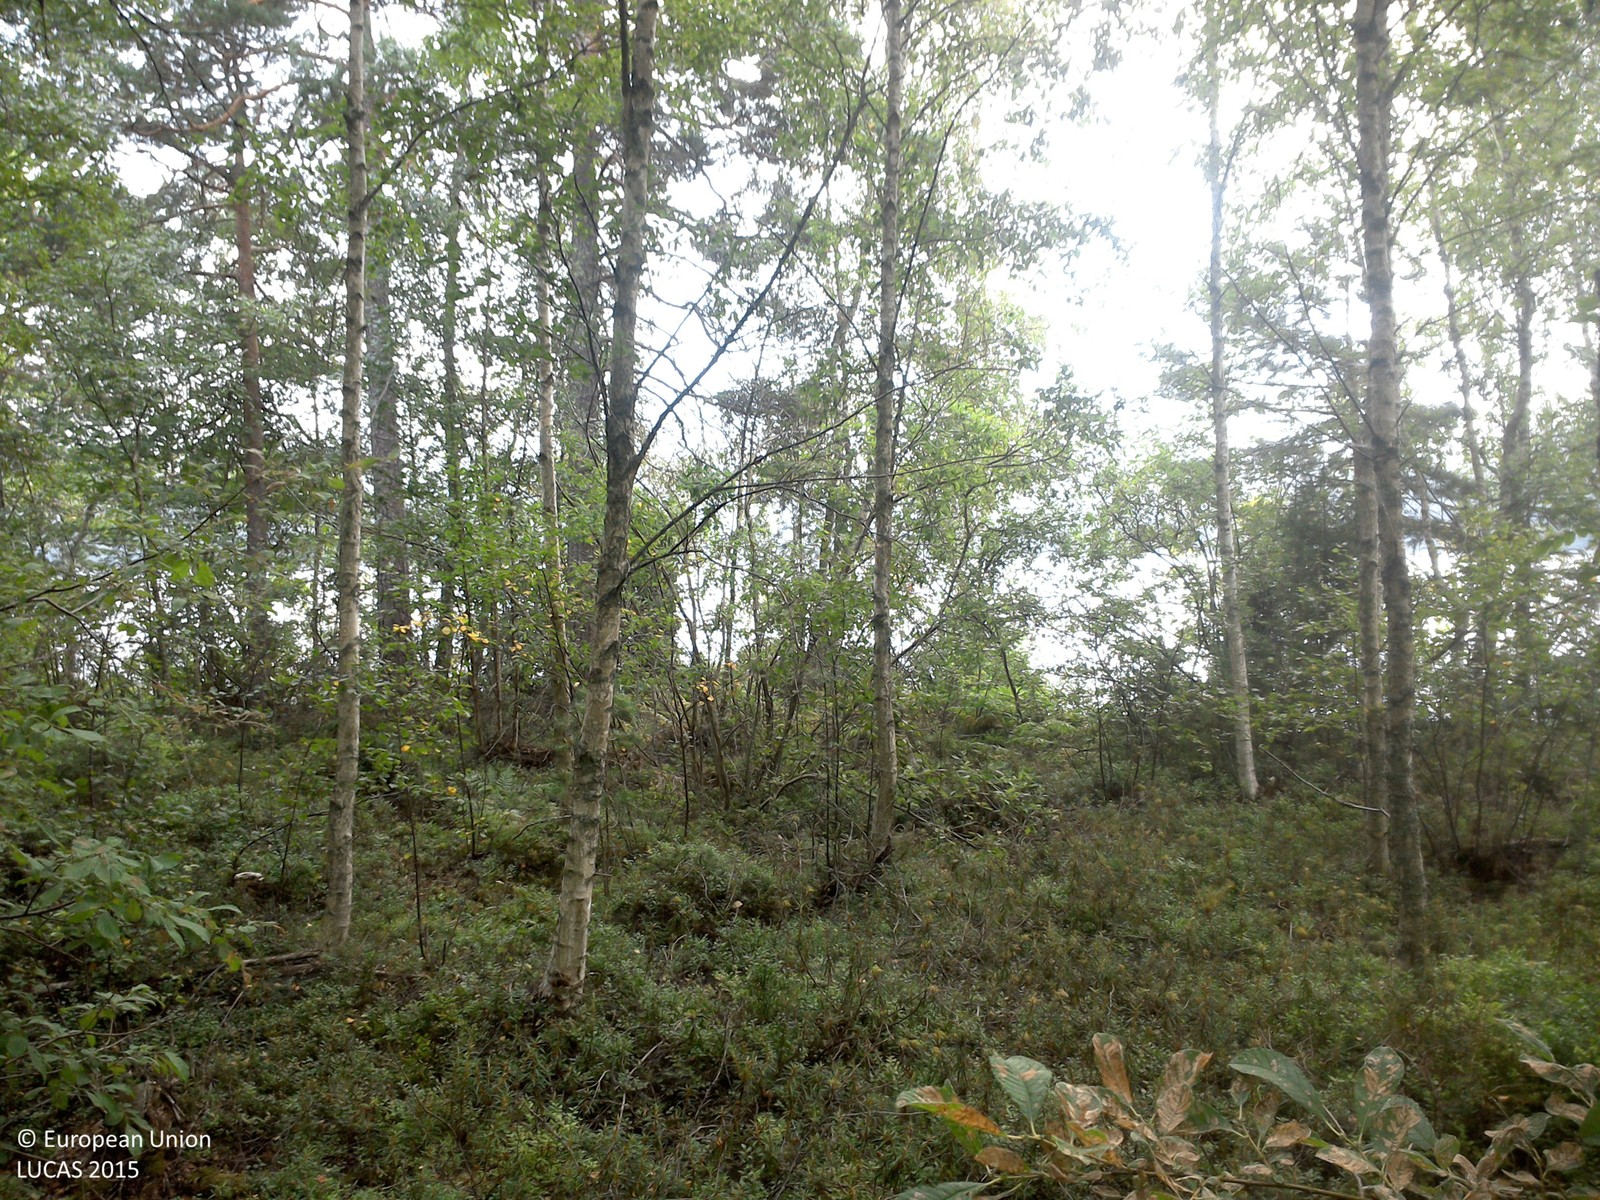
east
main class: Woodland
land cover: Broadleaved woodland
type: boreal forest
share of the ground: 50 - 75 %
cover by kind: broadleaved forest trees 50 %, lichens and mosses 35 %, herbaceous plants 15 %
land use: Forestry
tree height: > 5 m
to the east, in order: Tracks; Broadleaved woodland; Inland fresh water bodies
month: August
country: SE
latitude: 58.0417
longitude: 15.3310
